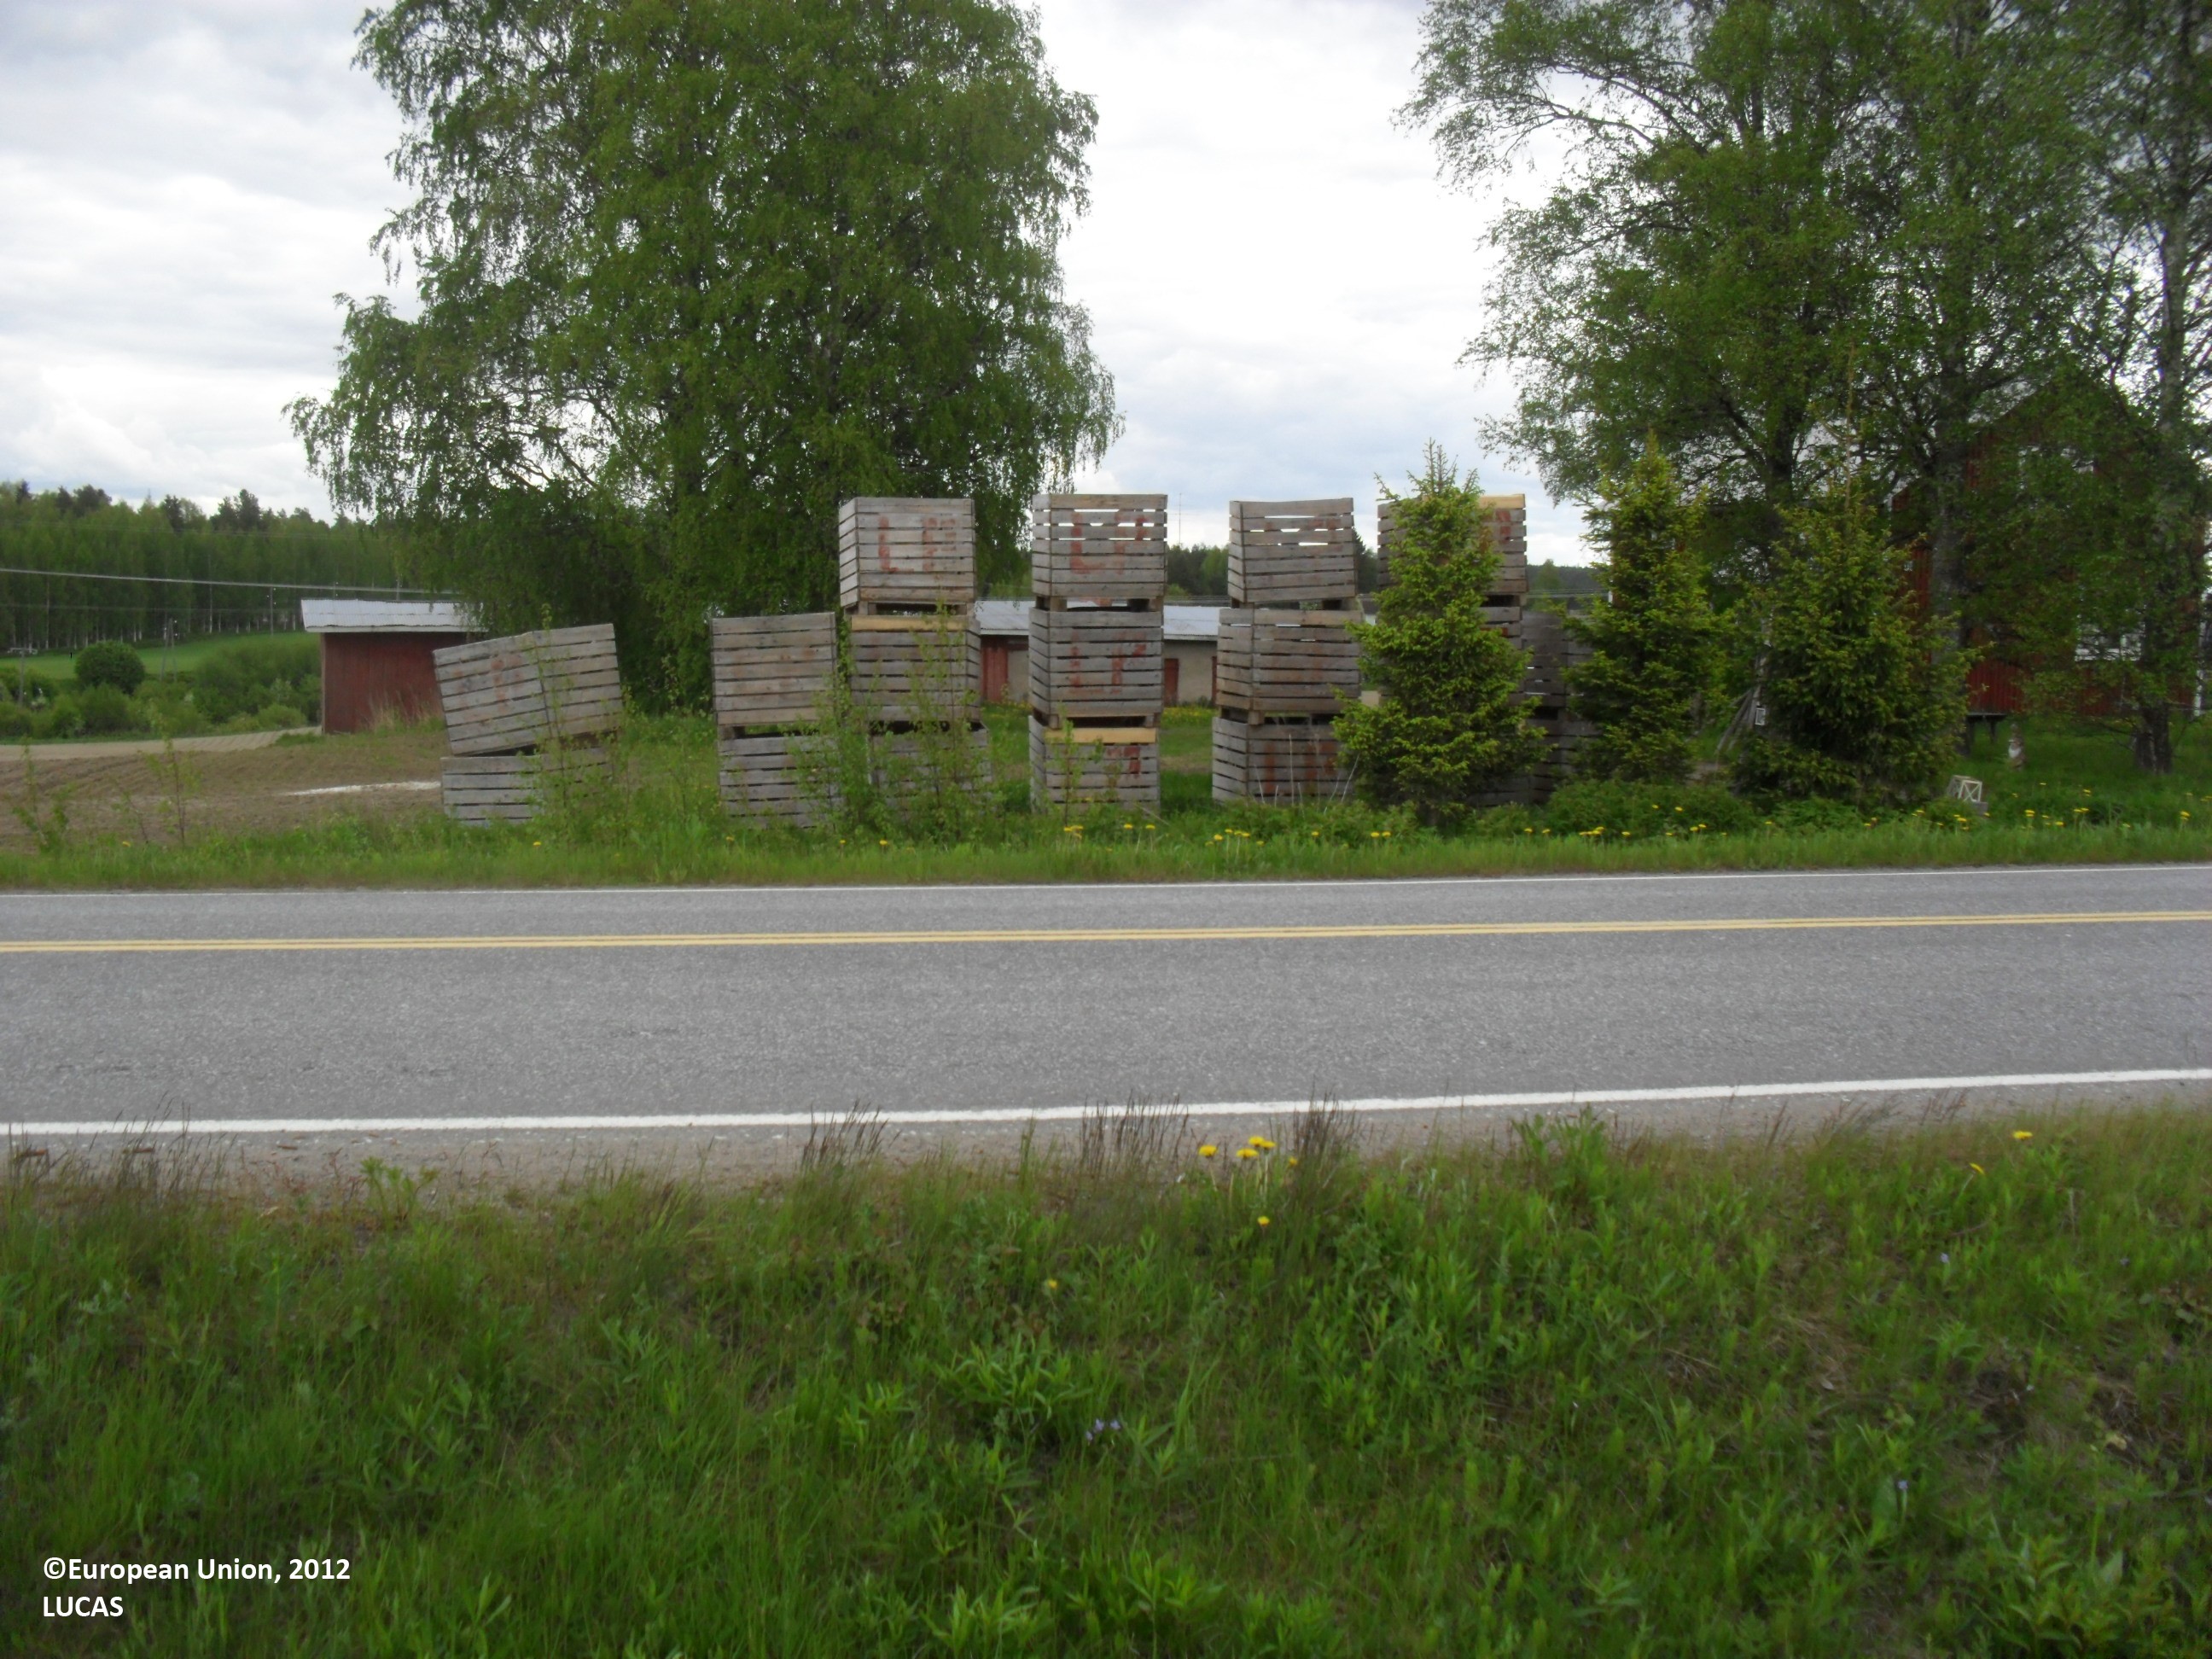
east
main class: Cropland
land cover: Oats
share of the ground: < 10 %
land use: Agriculture (excluding fallow land and kitchen gardens)
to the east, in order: Oats; Grass margins; Ditches and canals; Electric lines; Grassland without tree/shrub cover; Paved roads, cycling and walking lanes; Grassland without tree/shrub cover; Ditches and canals; Lines of trees; Artificial constructions in urban areas; Potatoes
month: June
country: FI
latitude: 62.9256
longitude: 22.9980
